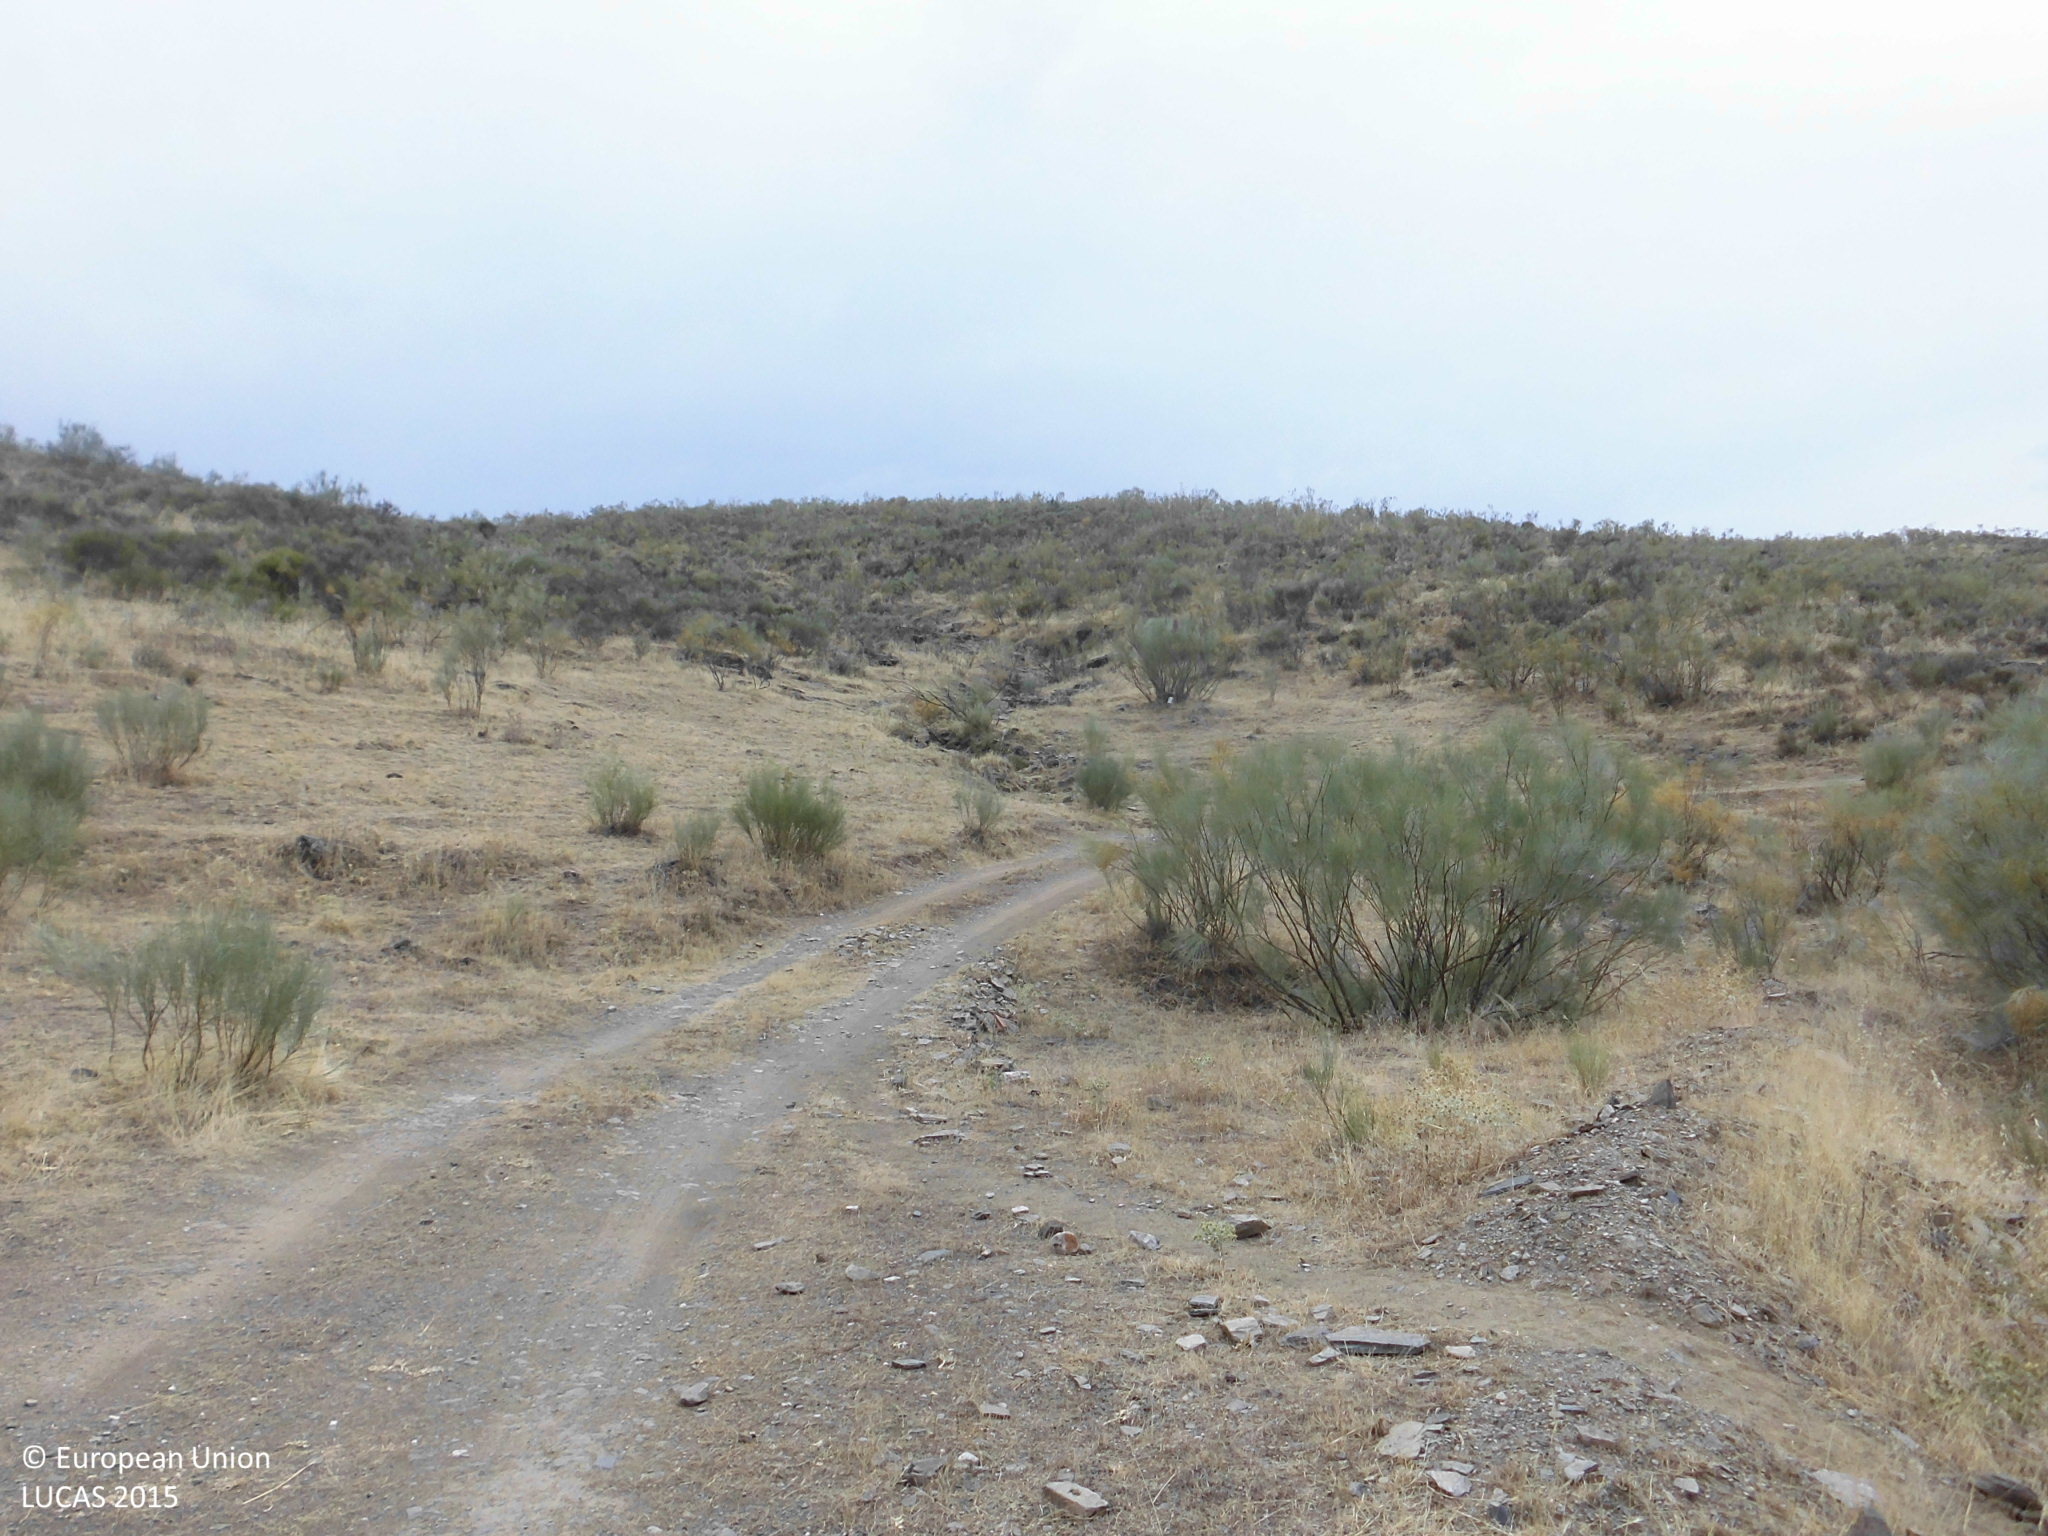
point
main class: Shrubland
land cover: Shrubland without tree cover
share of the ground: 25 - 50 %
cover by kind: shrubs 50 %, herbaceous plants 50 %
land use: Agriculture (excluding fallow land and kitchen gardens)
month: July
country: ES
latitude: 39.7581
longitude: -5.6410
